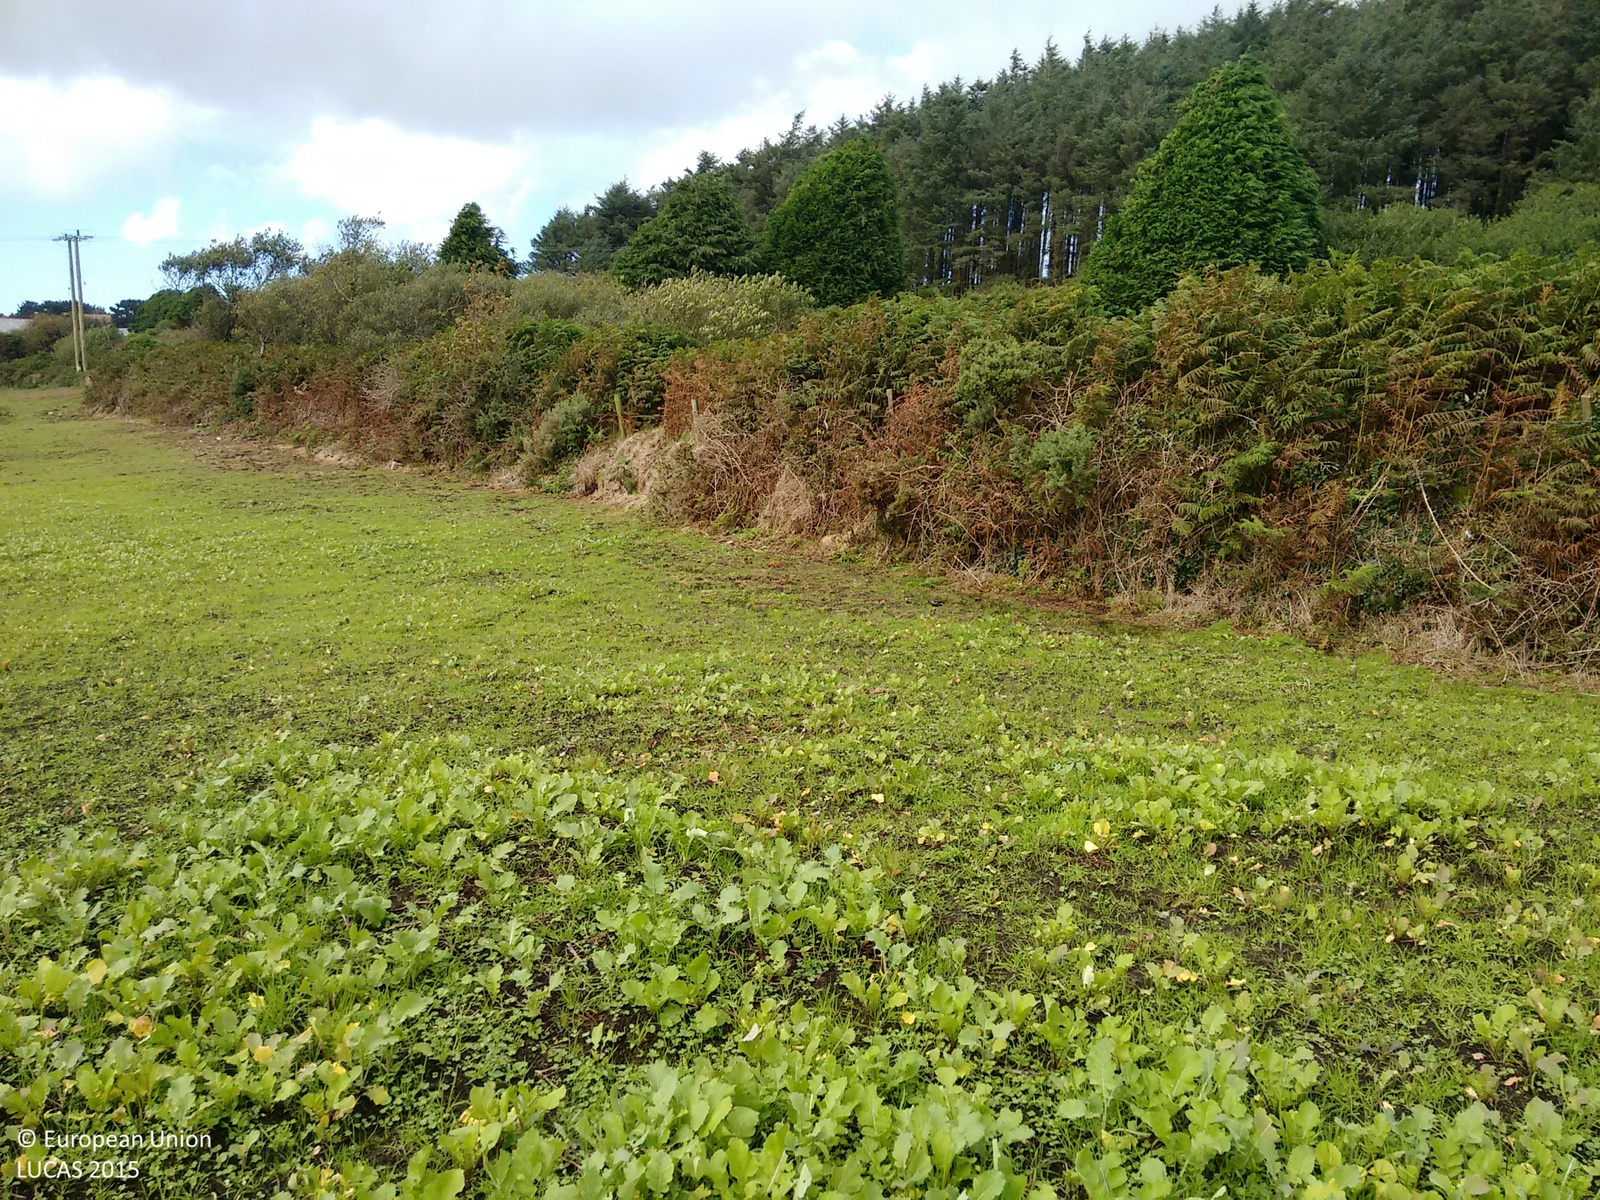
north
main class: Cropland
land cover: Other root crops
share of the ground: > 75 %
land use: Agriculture (excluding fallow land and kitchen gardens)
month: August
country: GB
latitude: 50.1544
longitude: -5.5383
